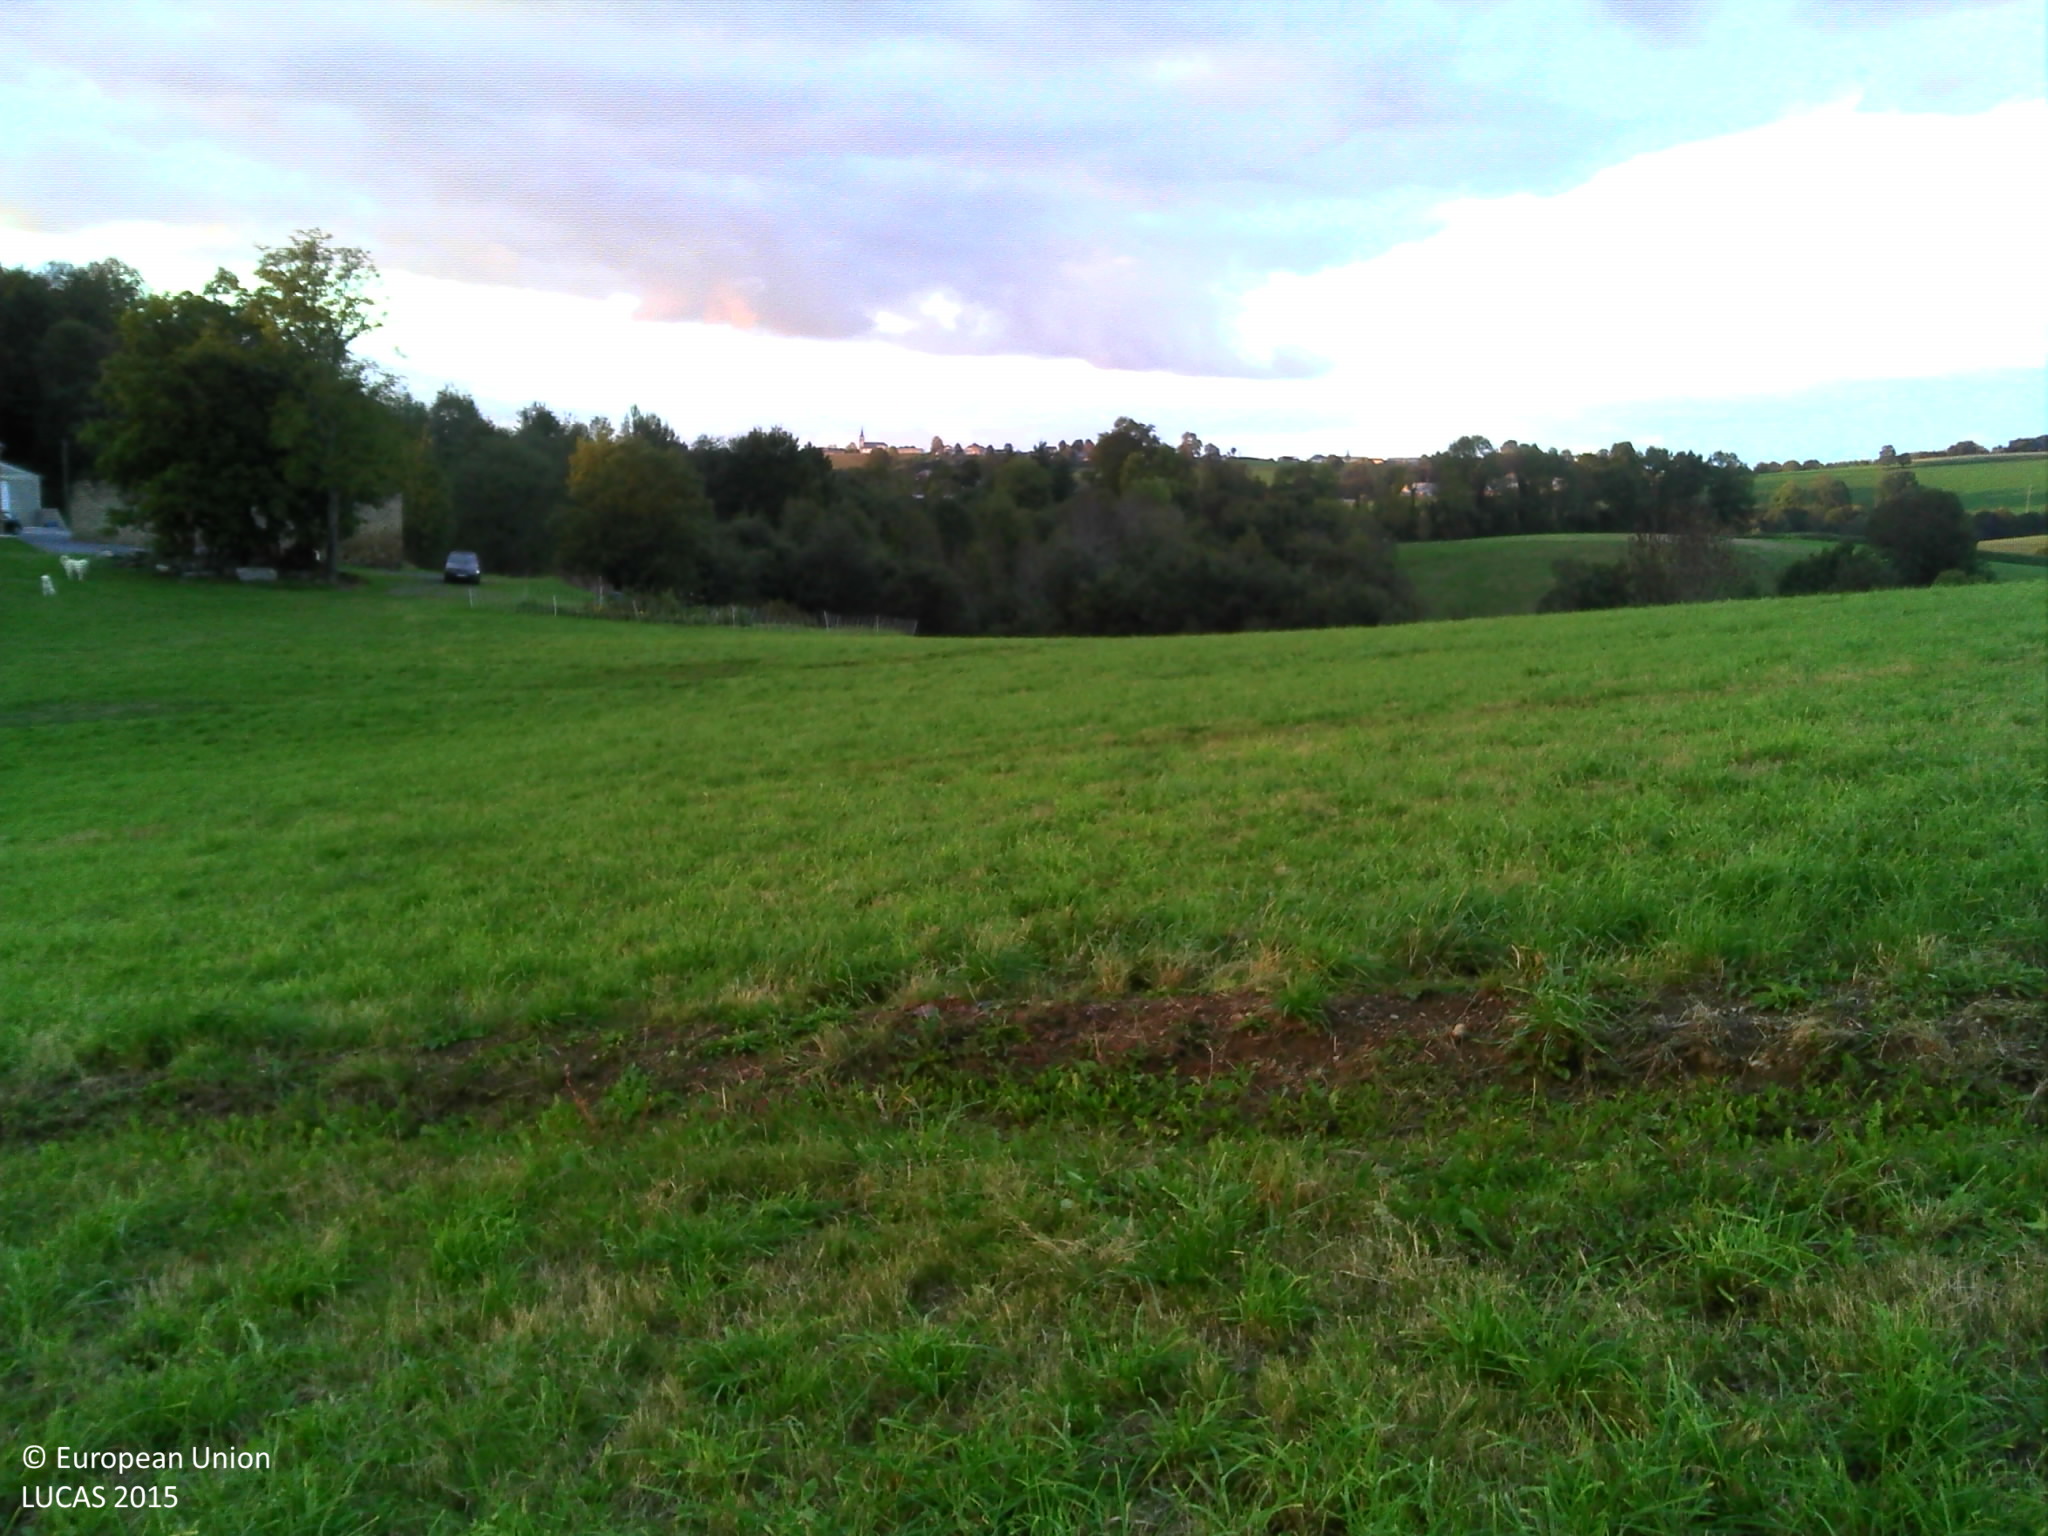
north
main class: Grassland
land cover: Grassland without tree/shrub cover
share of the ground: > 75 %
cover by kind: herbaceous plants 100 %
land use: Agriculture (excluding fallow land and kitchen gardens)
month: September
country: FR
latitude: 43.1432
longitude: -0.1476
